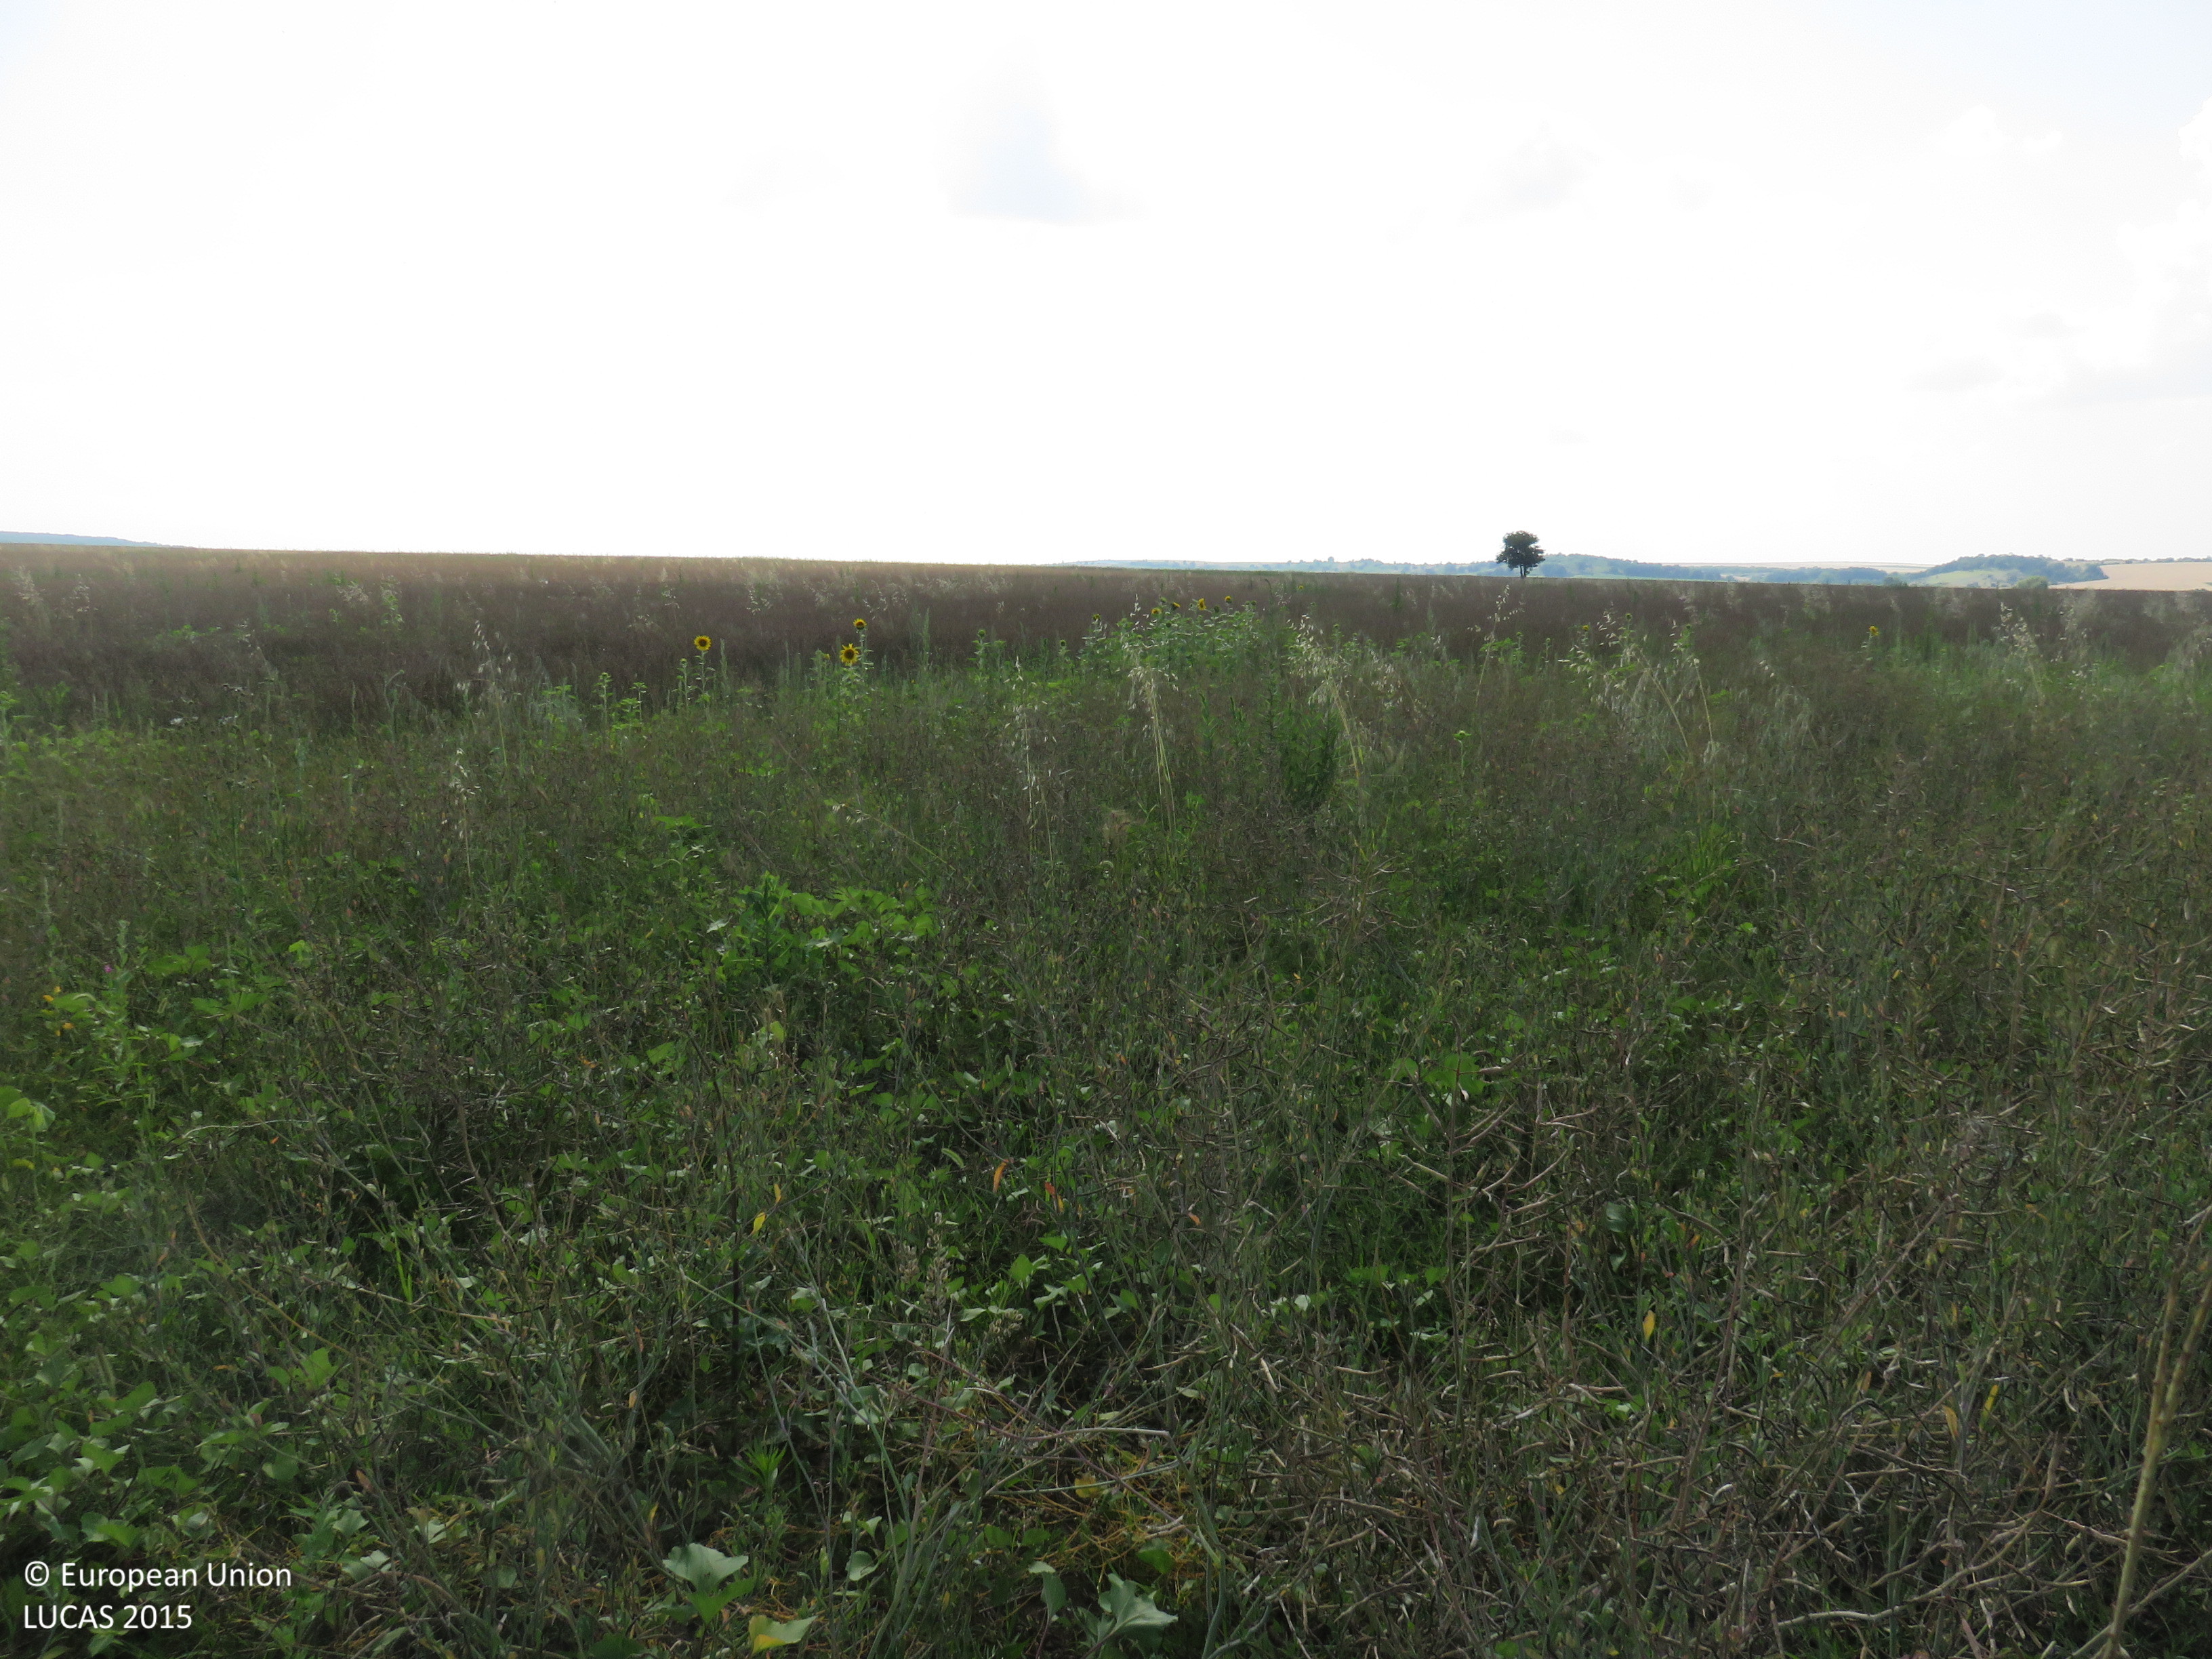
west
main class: Cropland
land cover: Rape and turnip rape
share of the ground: > 75 %
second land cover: Spontaneously vegetated surfaces
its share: 50 - 75 %
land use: Agriculture (excluding fallow land and kitchen gardens)
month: June
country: BG
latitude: 43.2941
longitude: 24.8445
